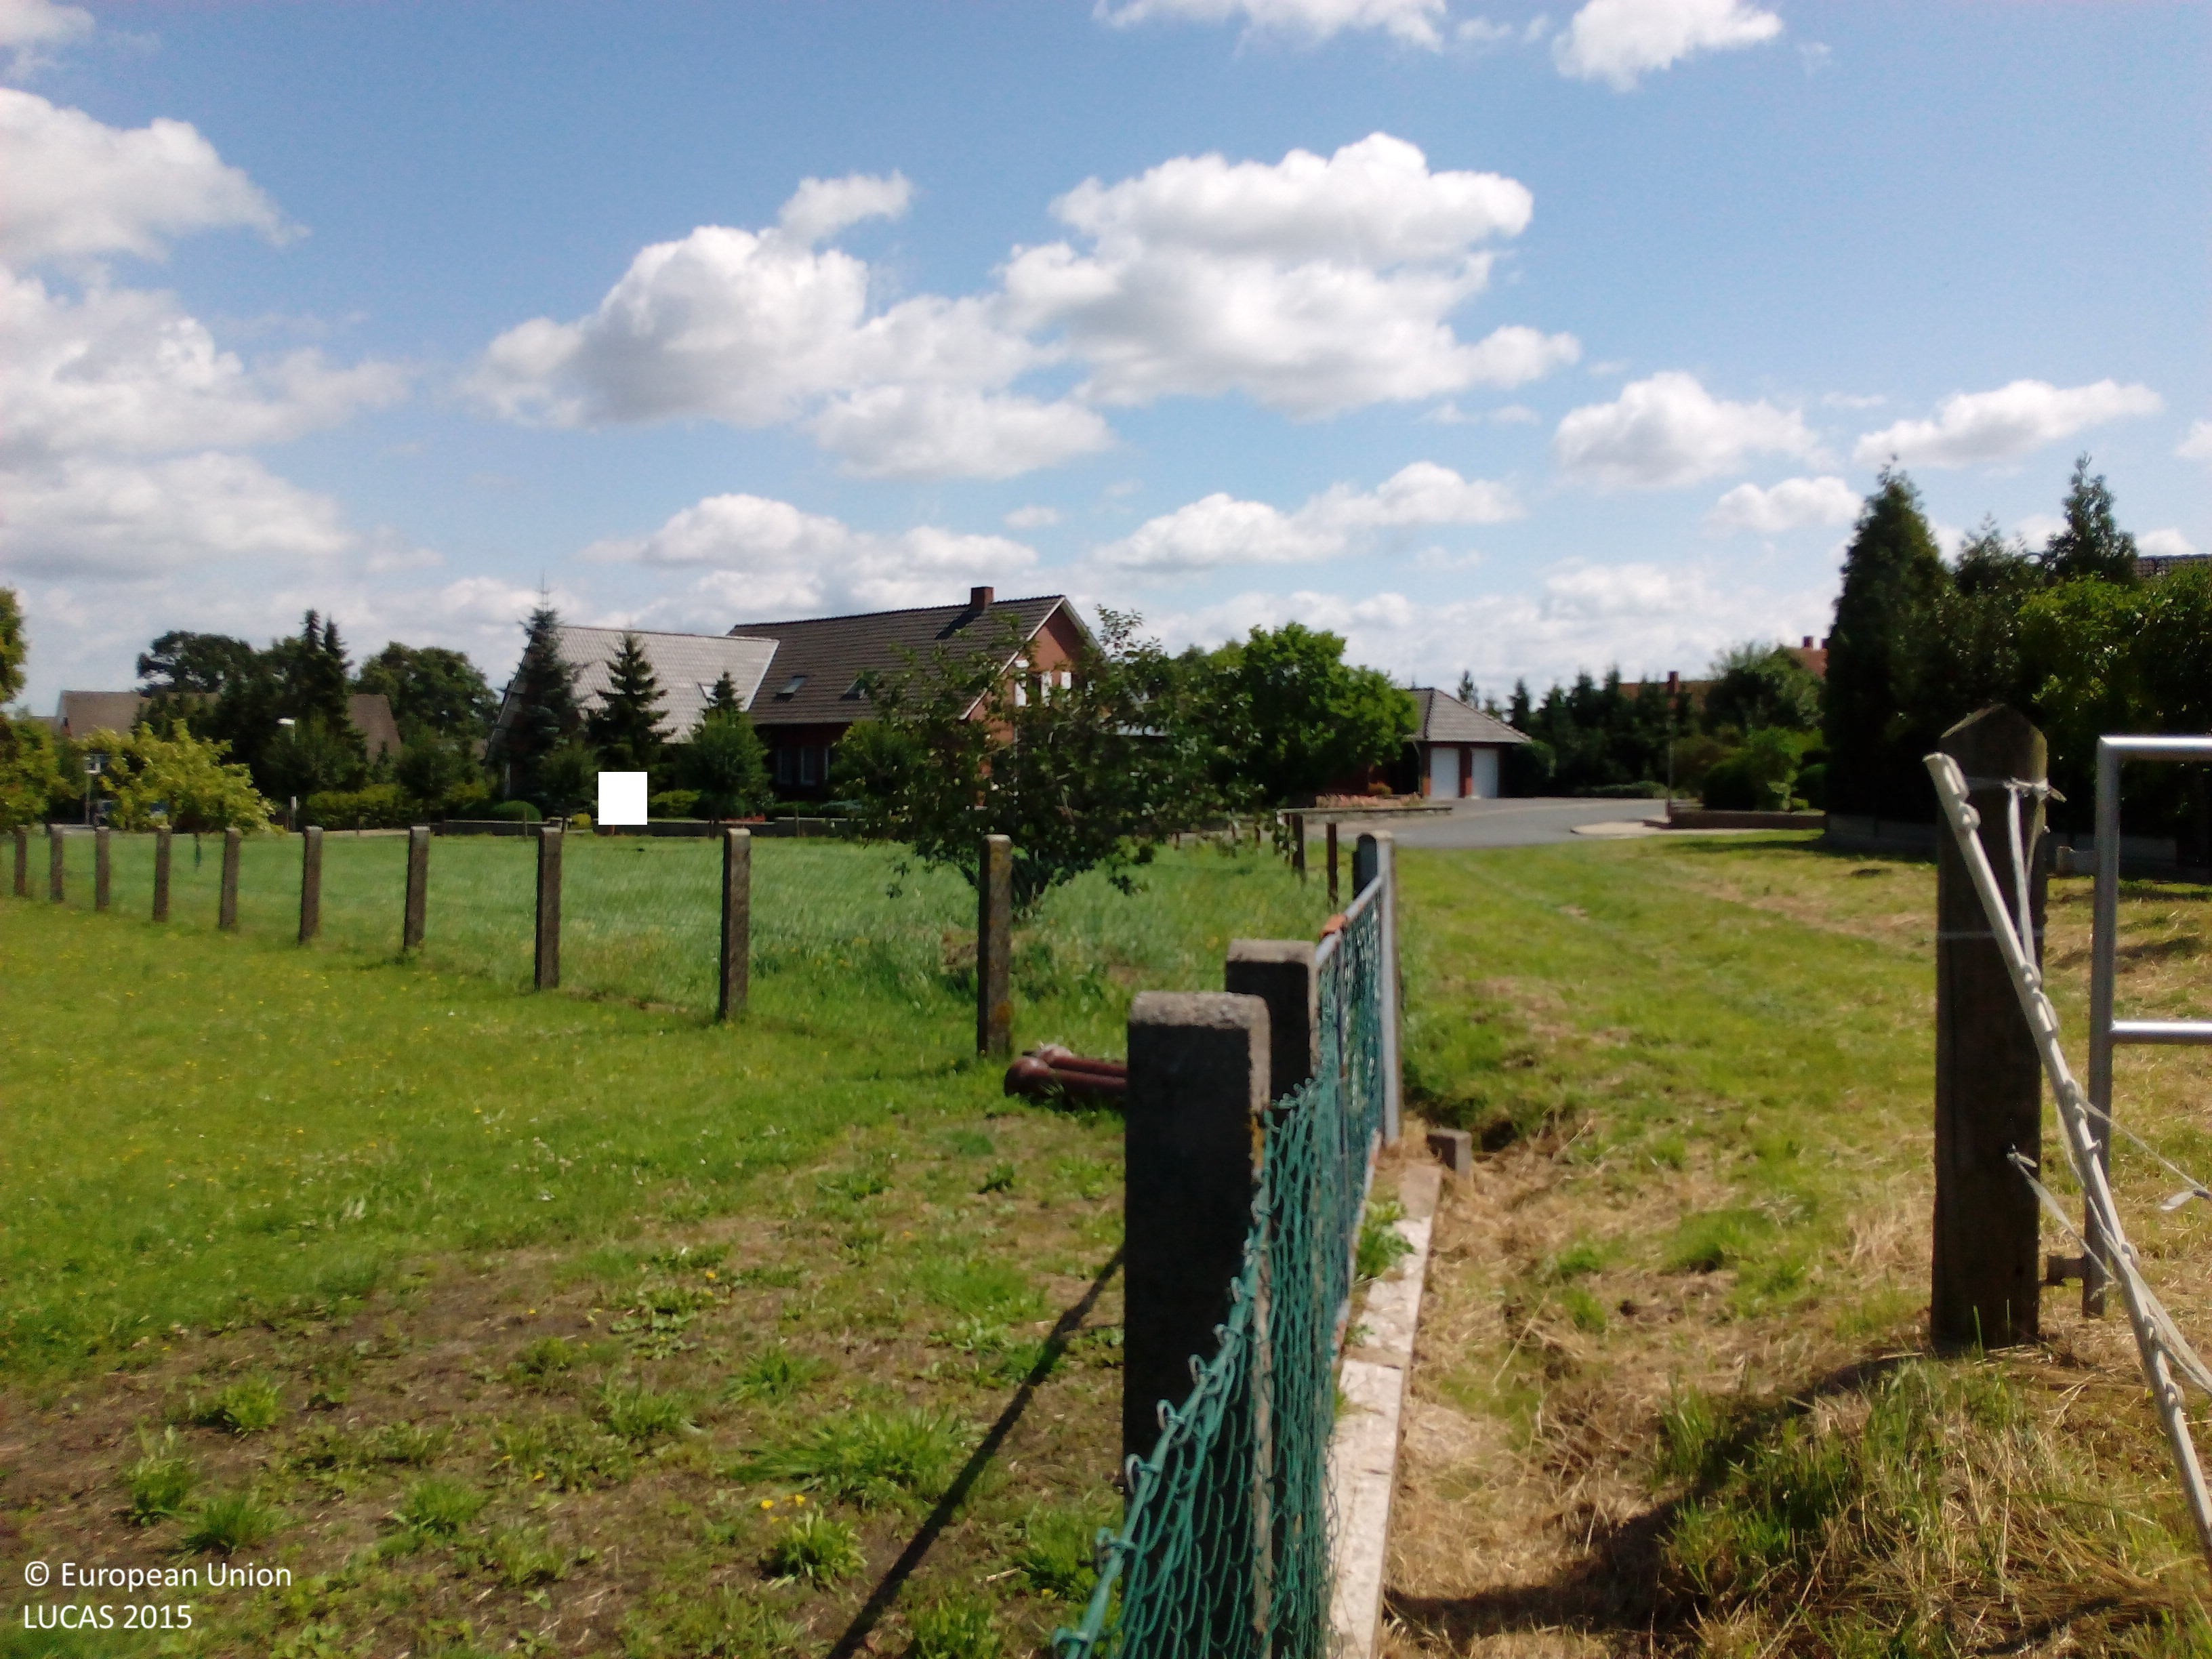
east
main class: Grassland
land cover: Grassland without tree/shrub cover
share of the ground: > 75 %
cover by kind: herbaceous plants 100 %
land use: Residential
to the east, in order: Grassland without tree/shrub cover; Artificial constructions in urban areas
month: July
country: DE
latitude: 52.2342
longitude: 7.9651
